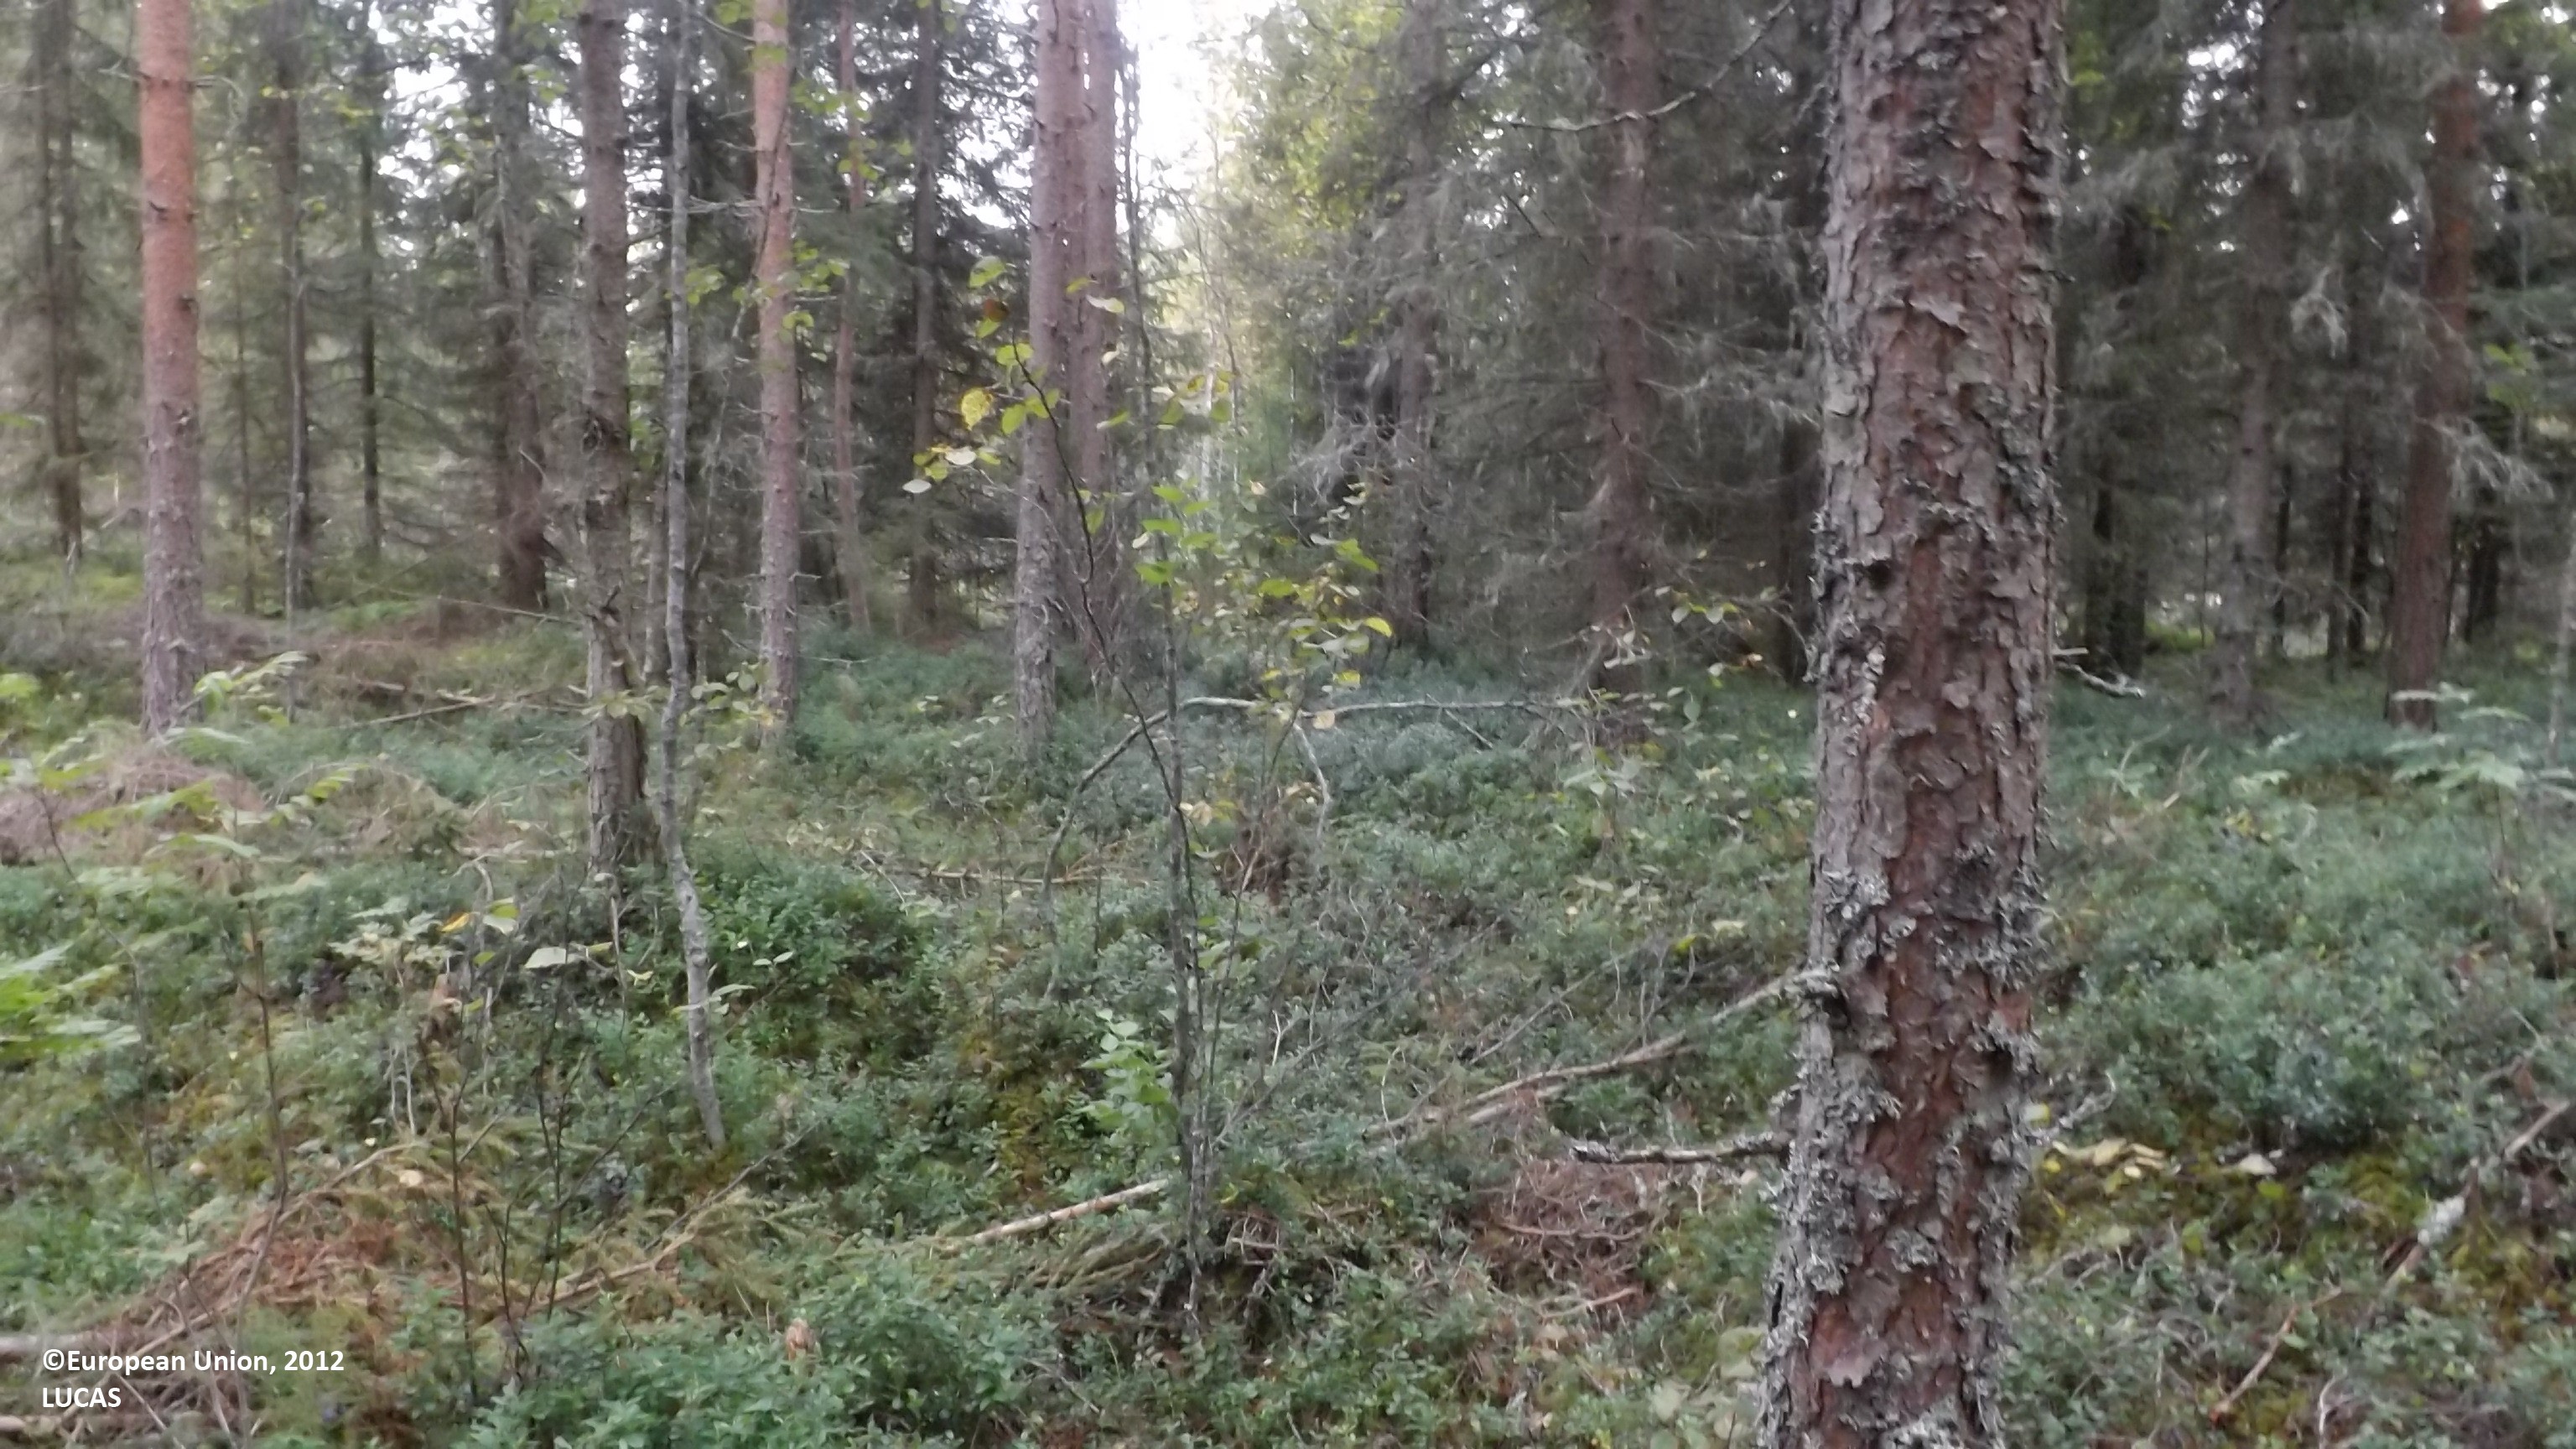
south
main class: Woodland
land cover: Pine dominated mixed woodland
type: boreal forest
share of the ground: 50 - 75 %
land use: Forestry
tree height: > 5 m
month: August
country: FI
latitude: 63.8227
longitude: 23.4470
